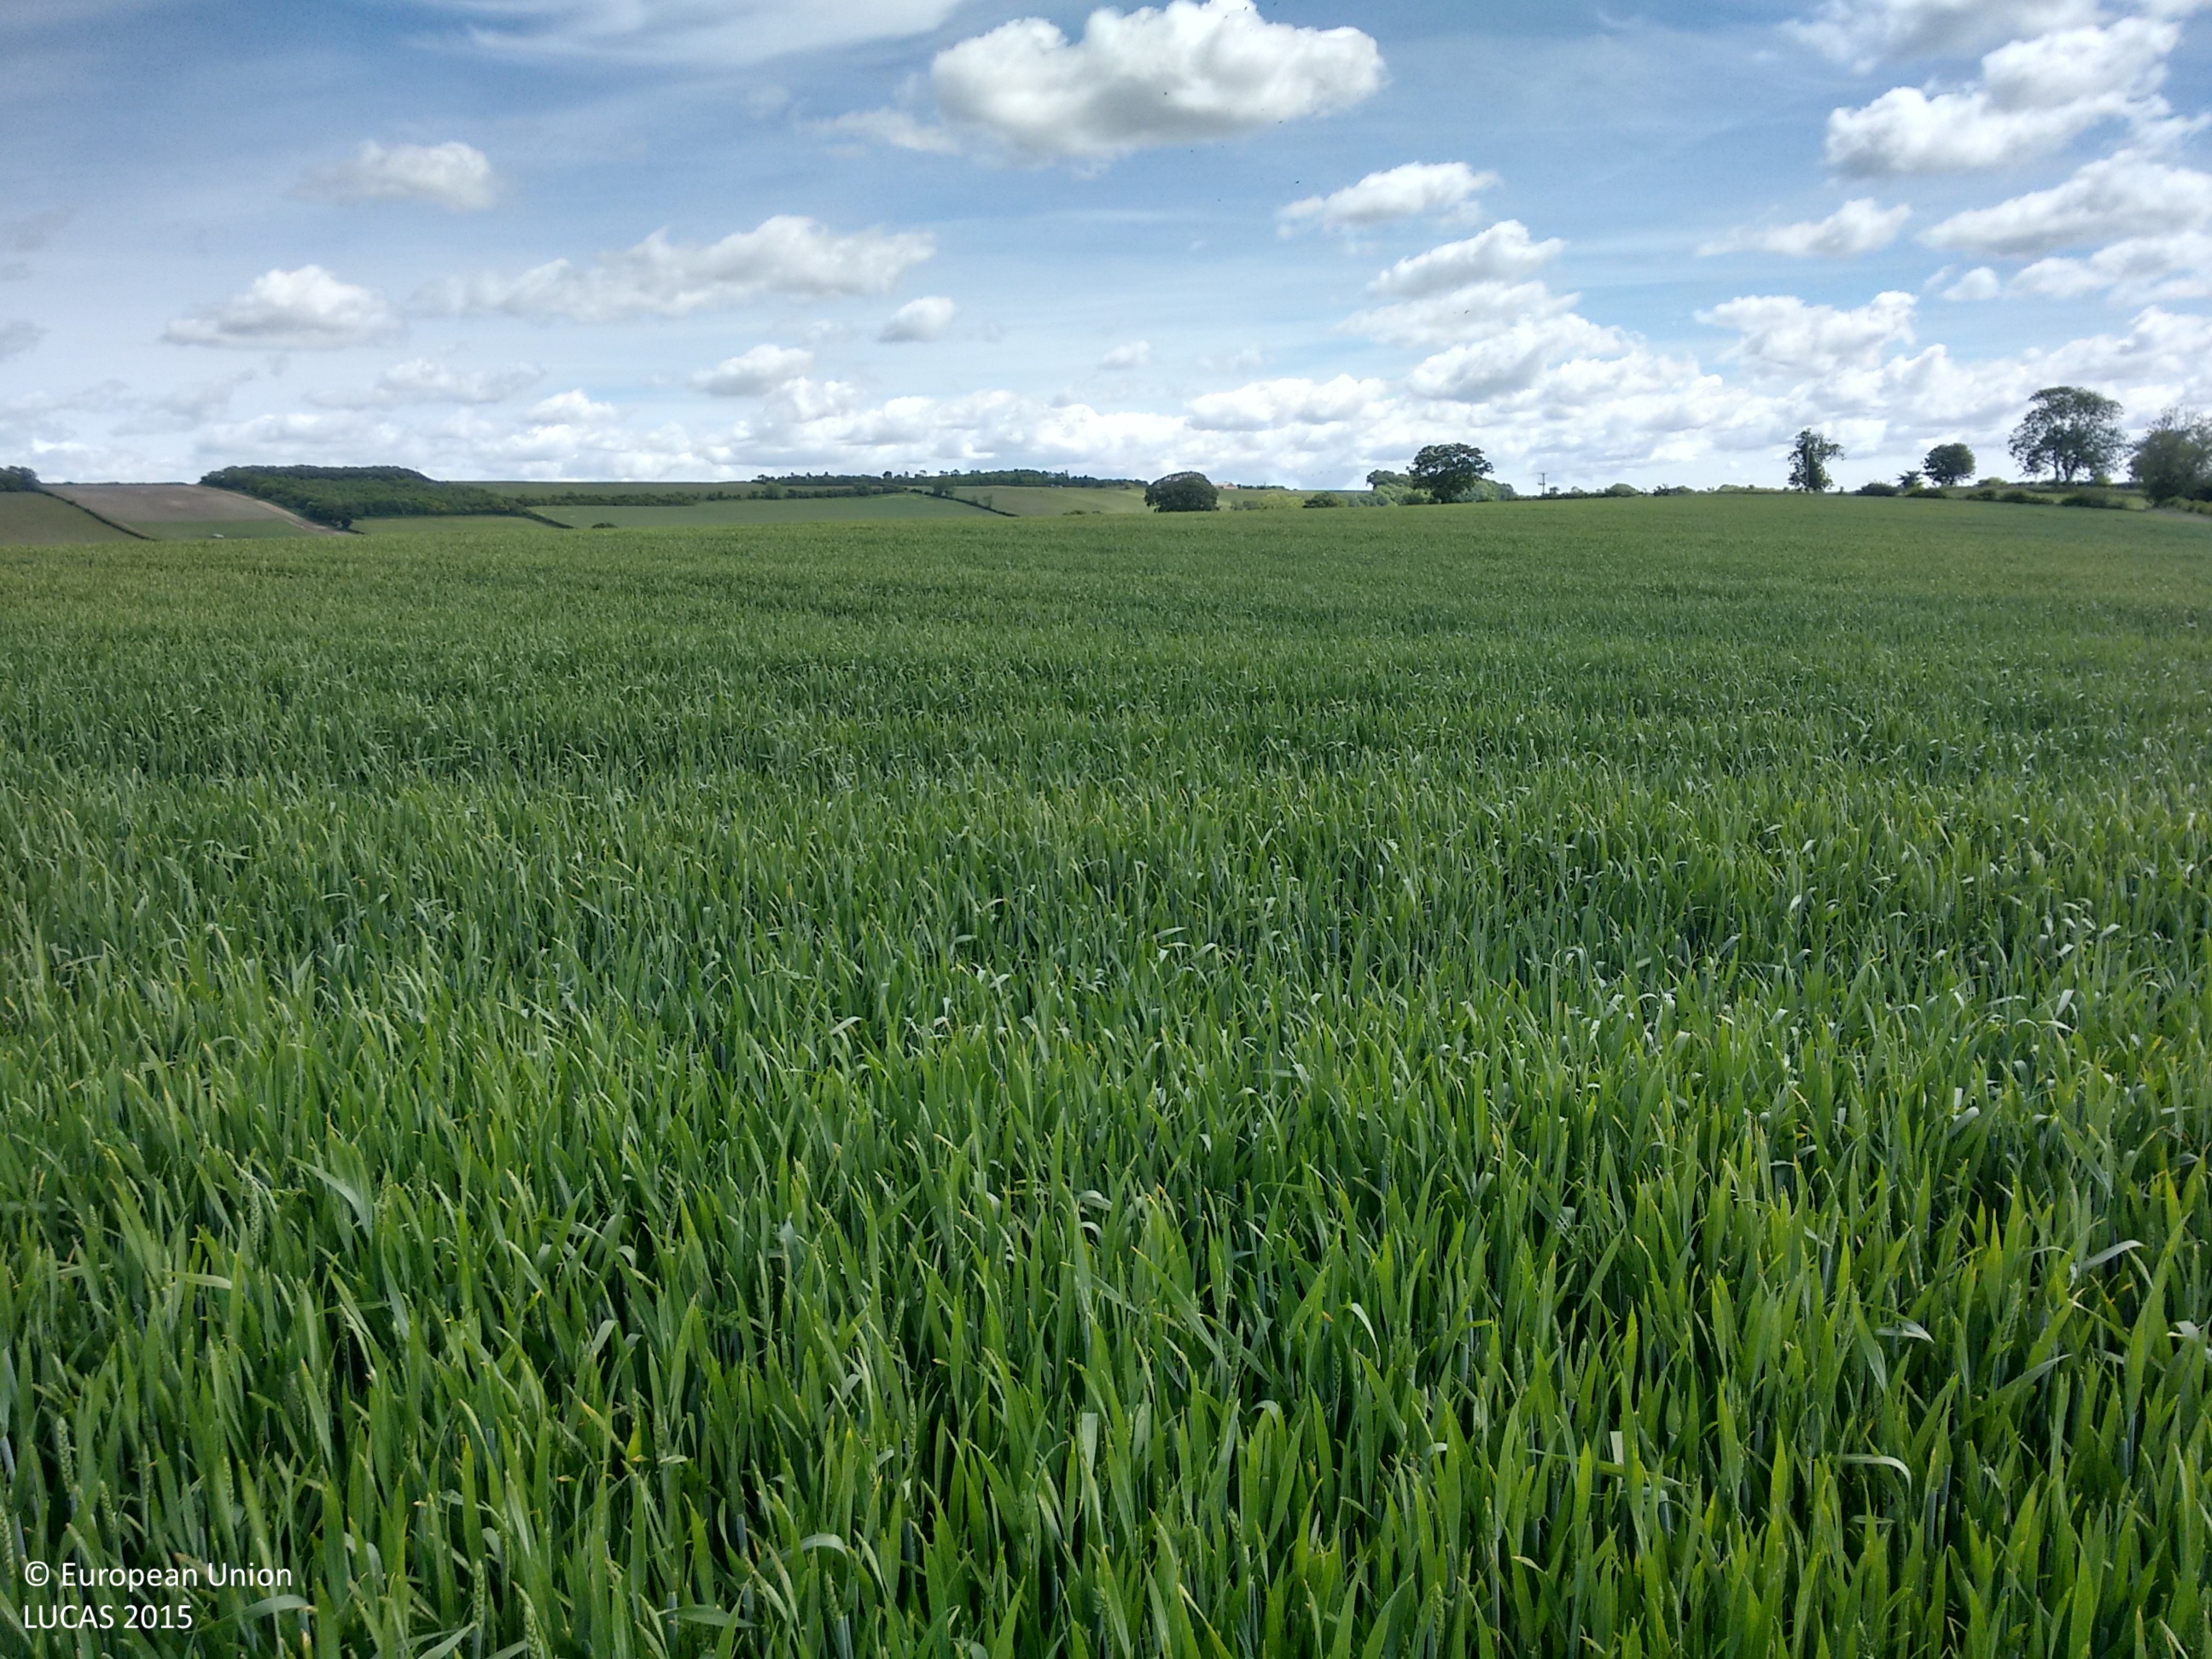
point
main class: Cropland
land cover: Common wheat
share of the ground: > 75 %
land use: Agriculture (excluding fallow land and kitchen gardens)
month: June
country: GB
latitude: 54.0978
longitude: -0.7898
